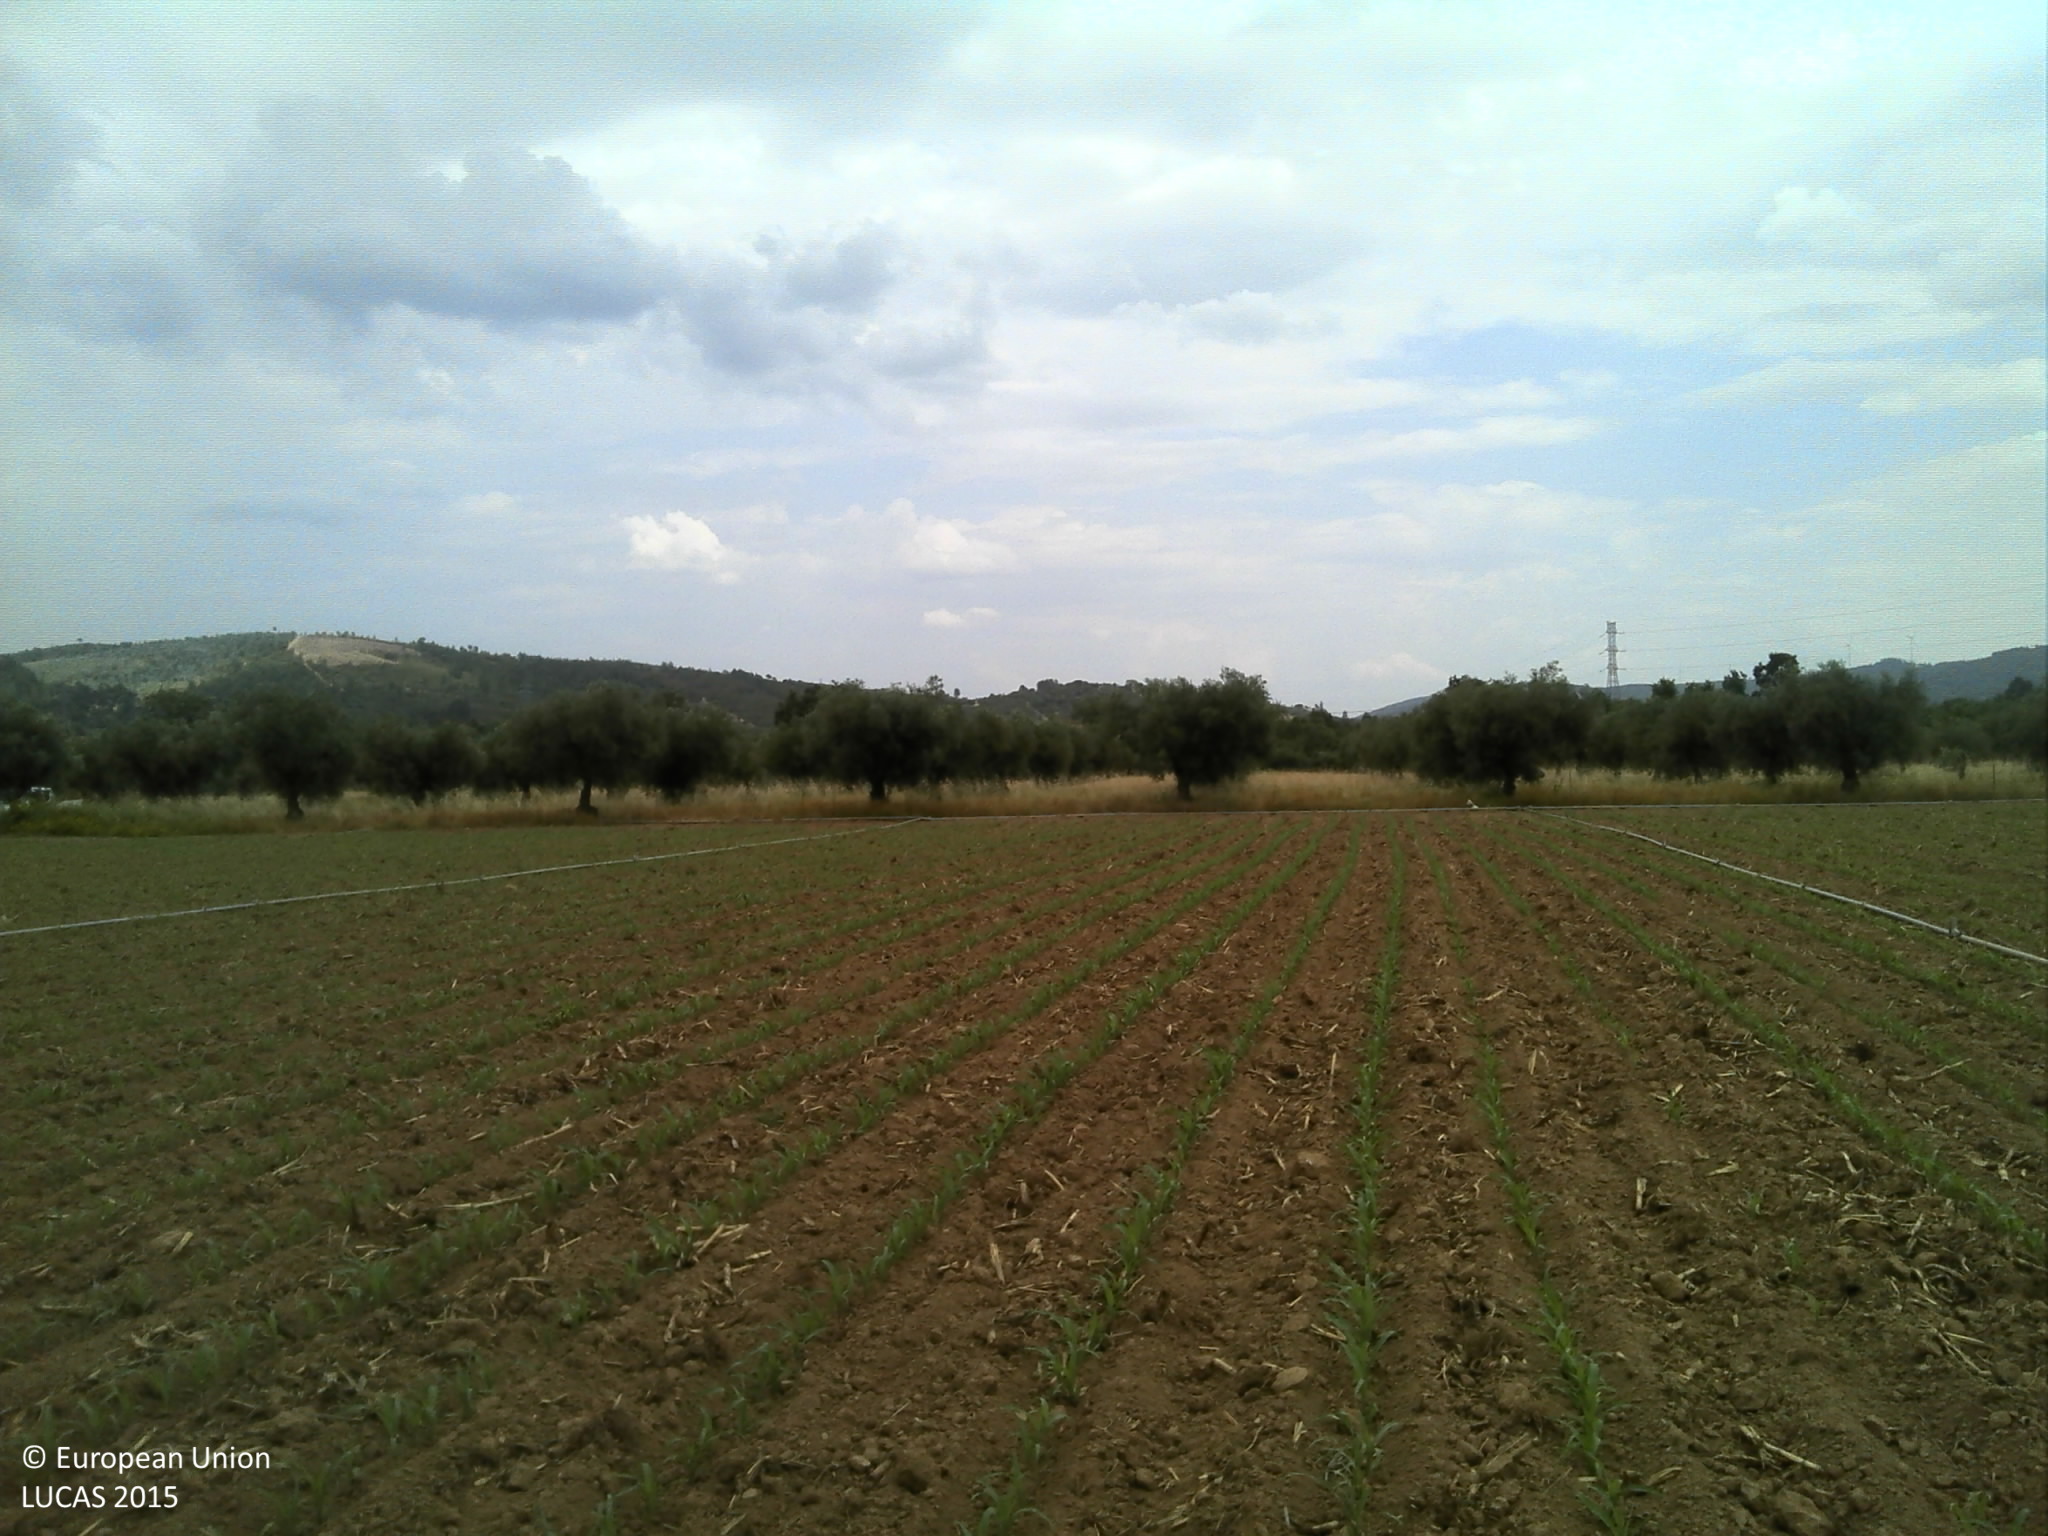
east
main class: Cropland
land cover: Maize
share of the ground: < 10 %
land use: Agriculture (excluding fallow land and kitchen gardens)
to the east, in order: Maize; Other bare soil; Fences; Grass margins; Olive groves; Fences; Shruby margins; Ditches and canals; Shruby margins; Olive groves
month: June
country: PT
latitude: 40.2431
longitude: -7.2270
